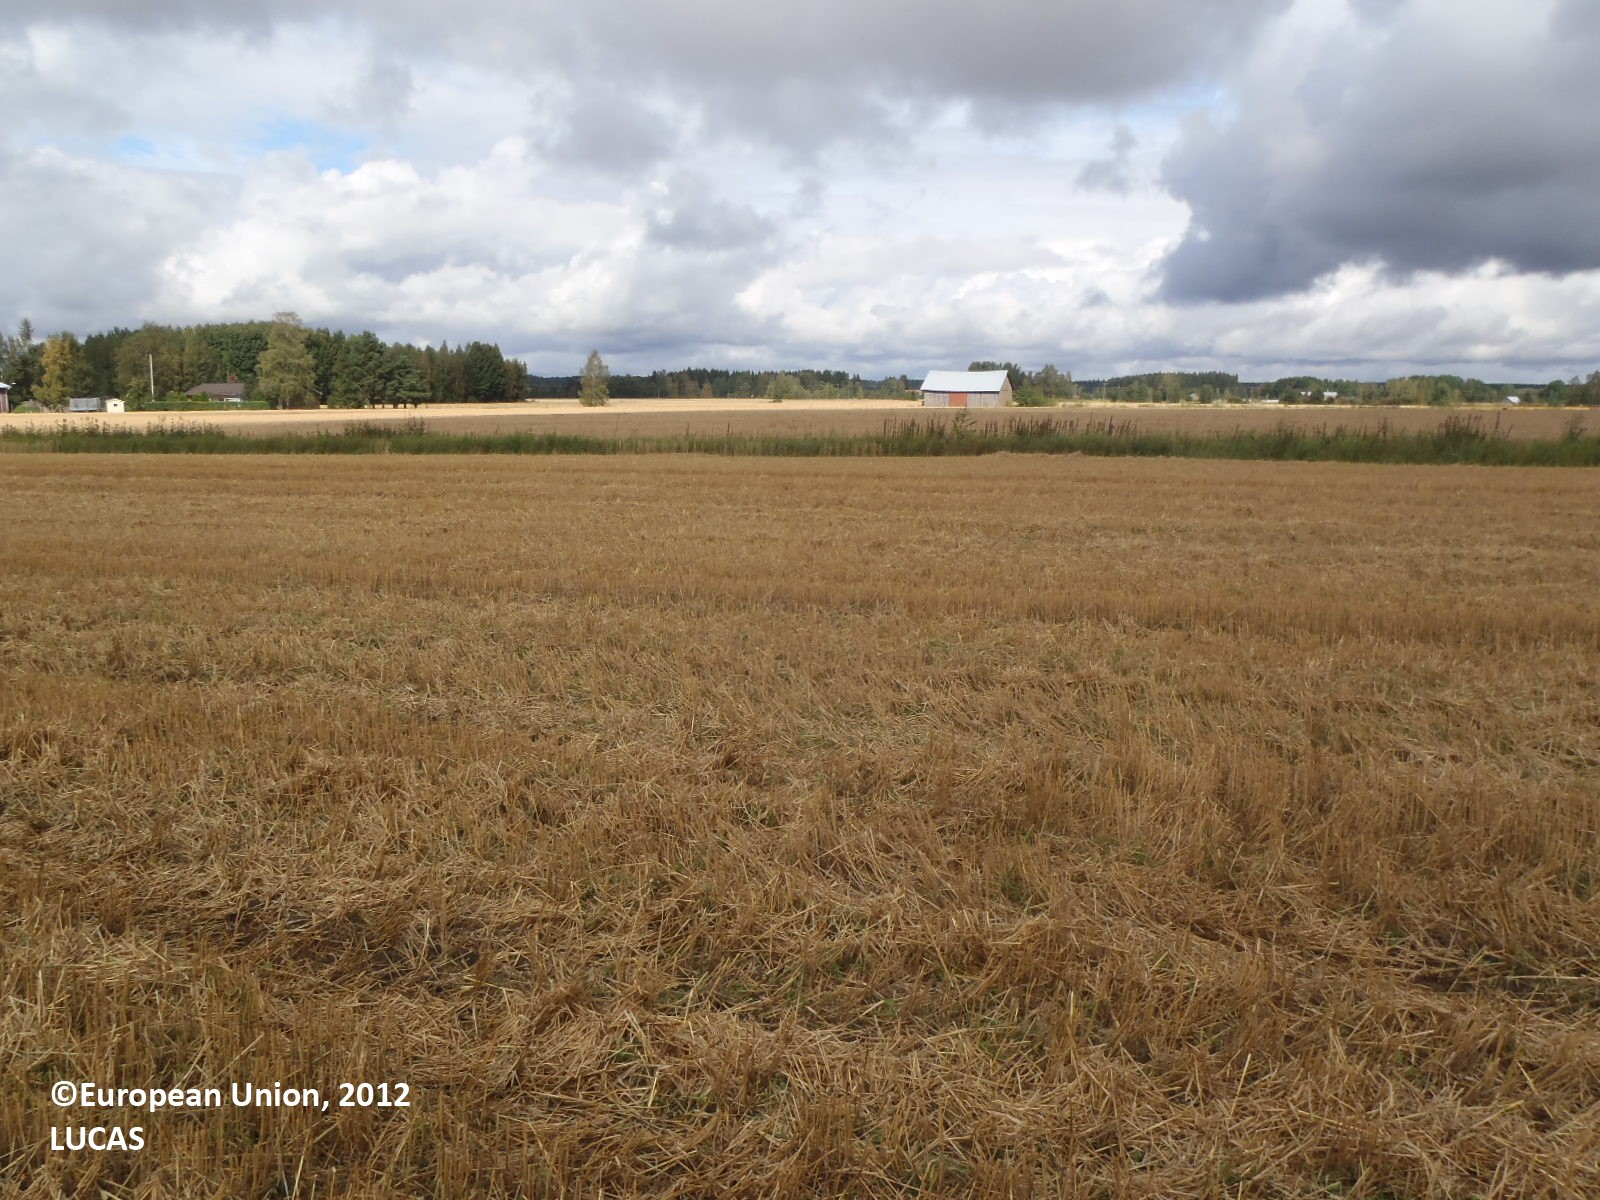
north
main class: Cropland
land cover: Barley
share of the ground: 50 - 75 %
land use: Agriculture (excluding fallow land and kitchen gardens)
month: September
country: FI
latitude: 61.0603
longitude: 22.7608
